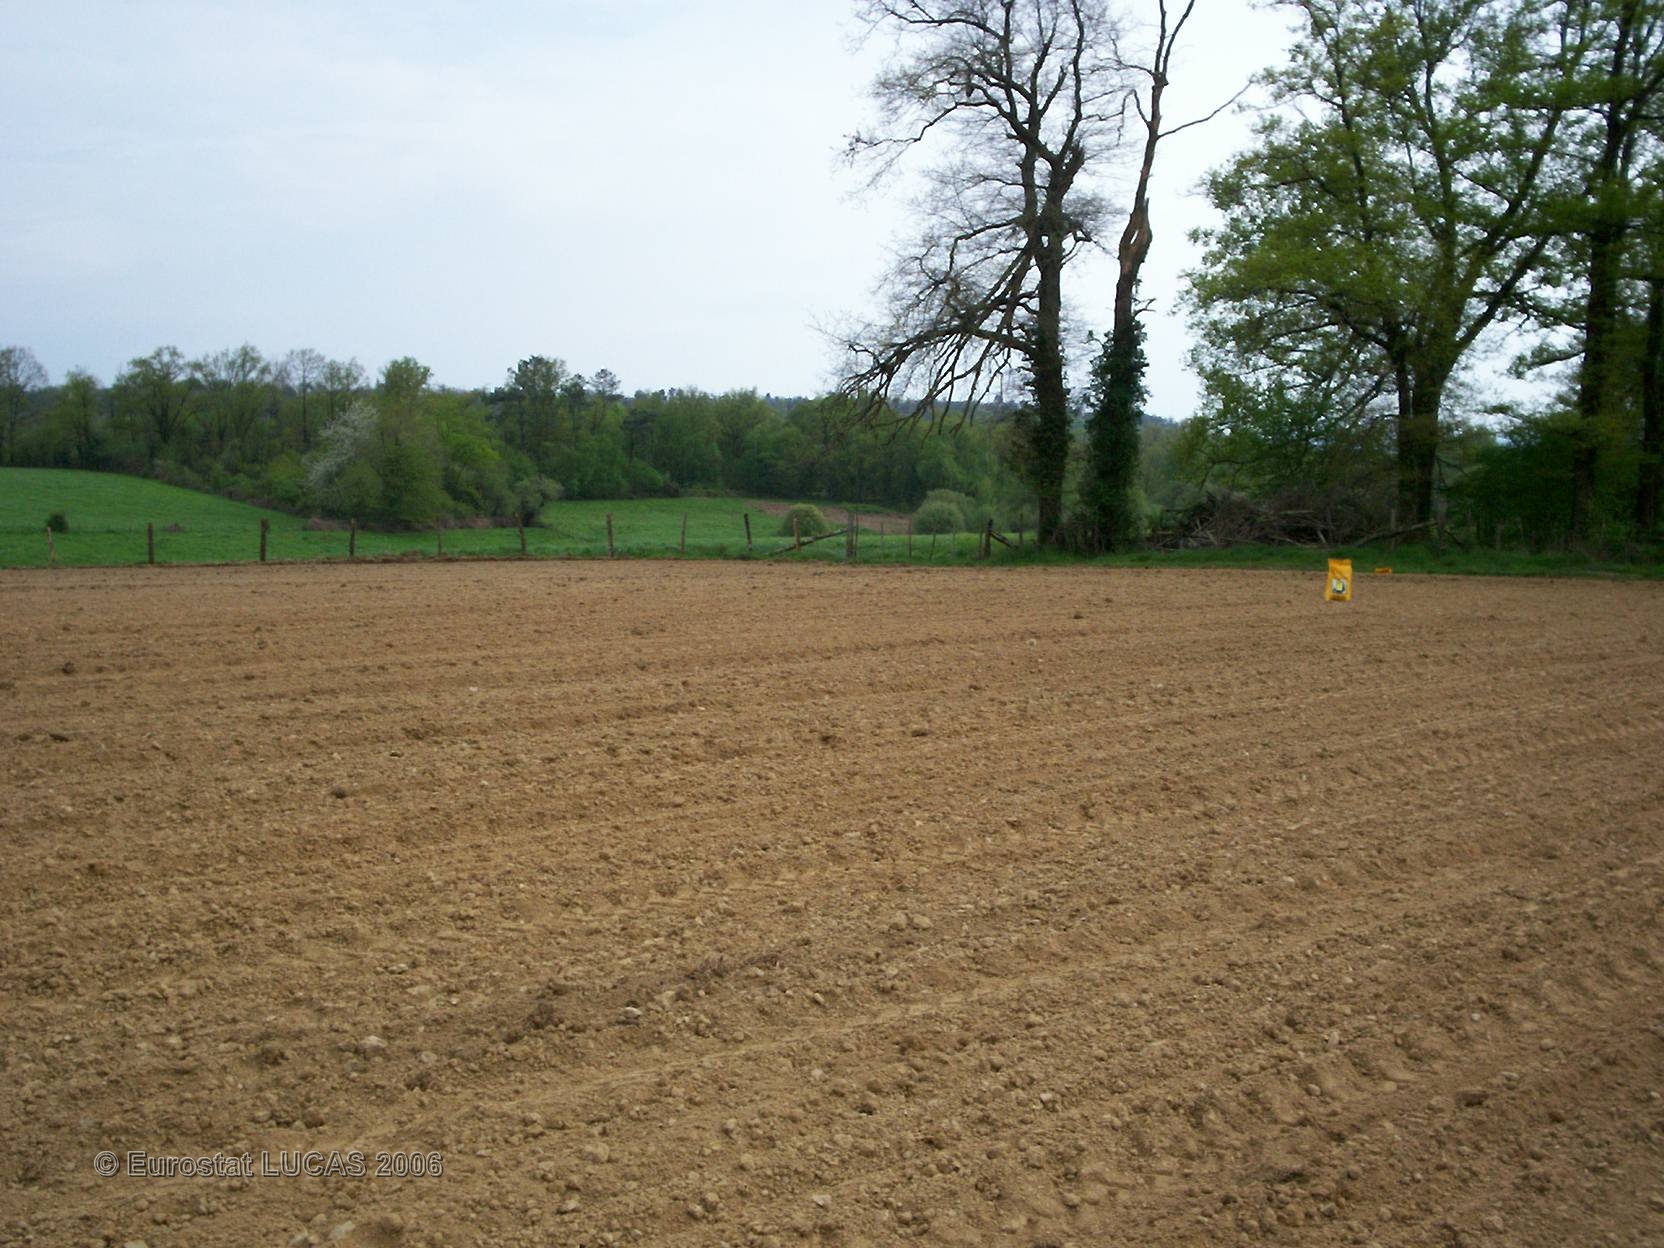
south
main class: Bare land
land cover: Bare land
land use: Agriculture (excluding fallow land and kitchen gardens)
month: April
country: FR
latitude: 45.4998
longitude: 0.7876
